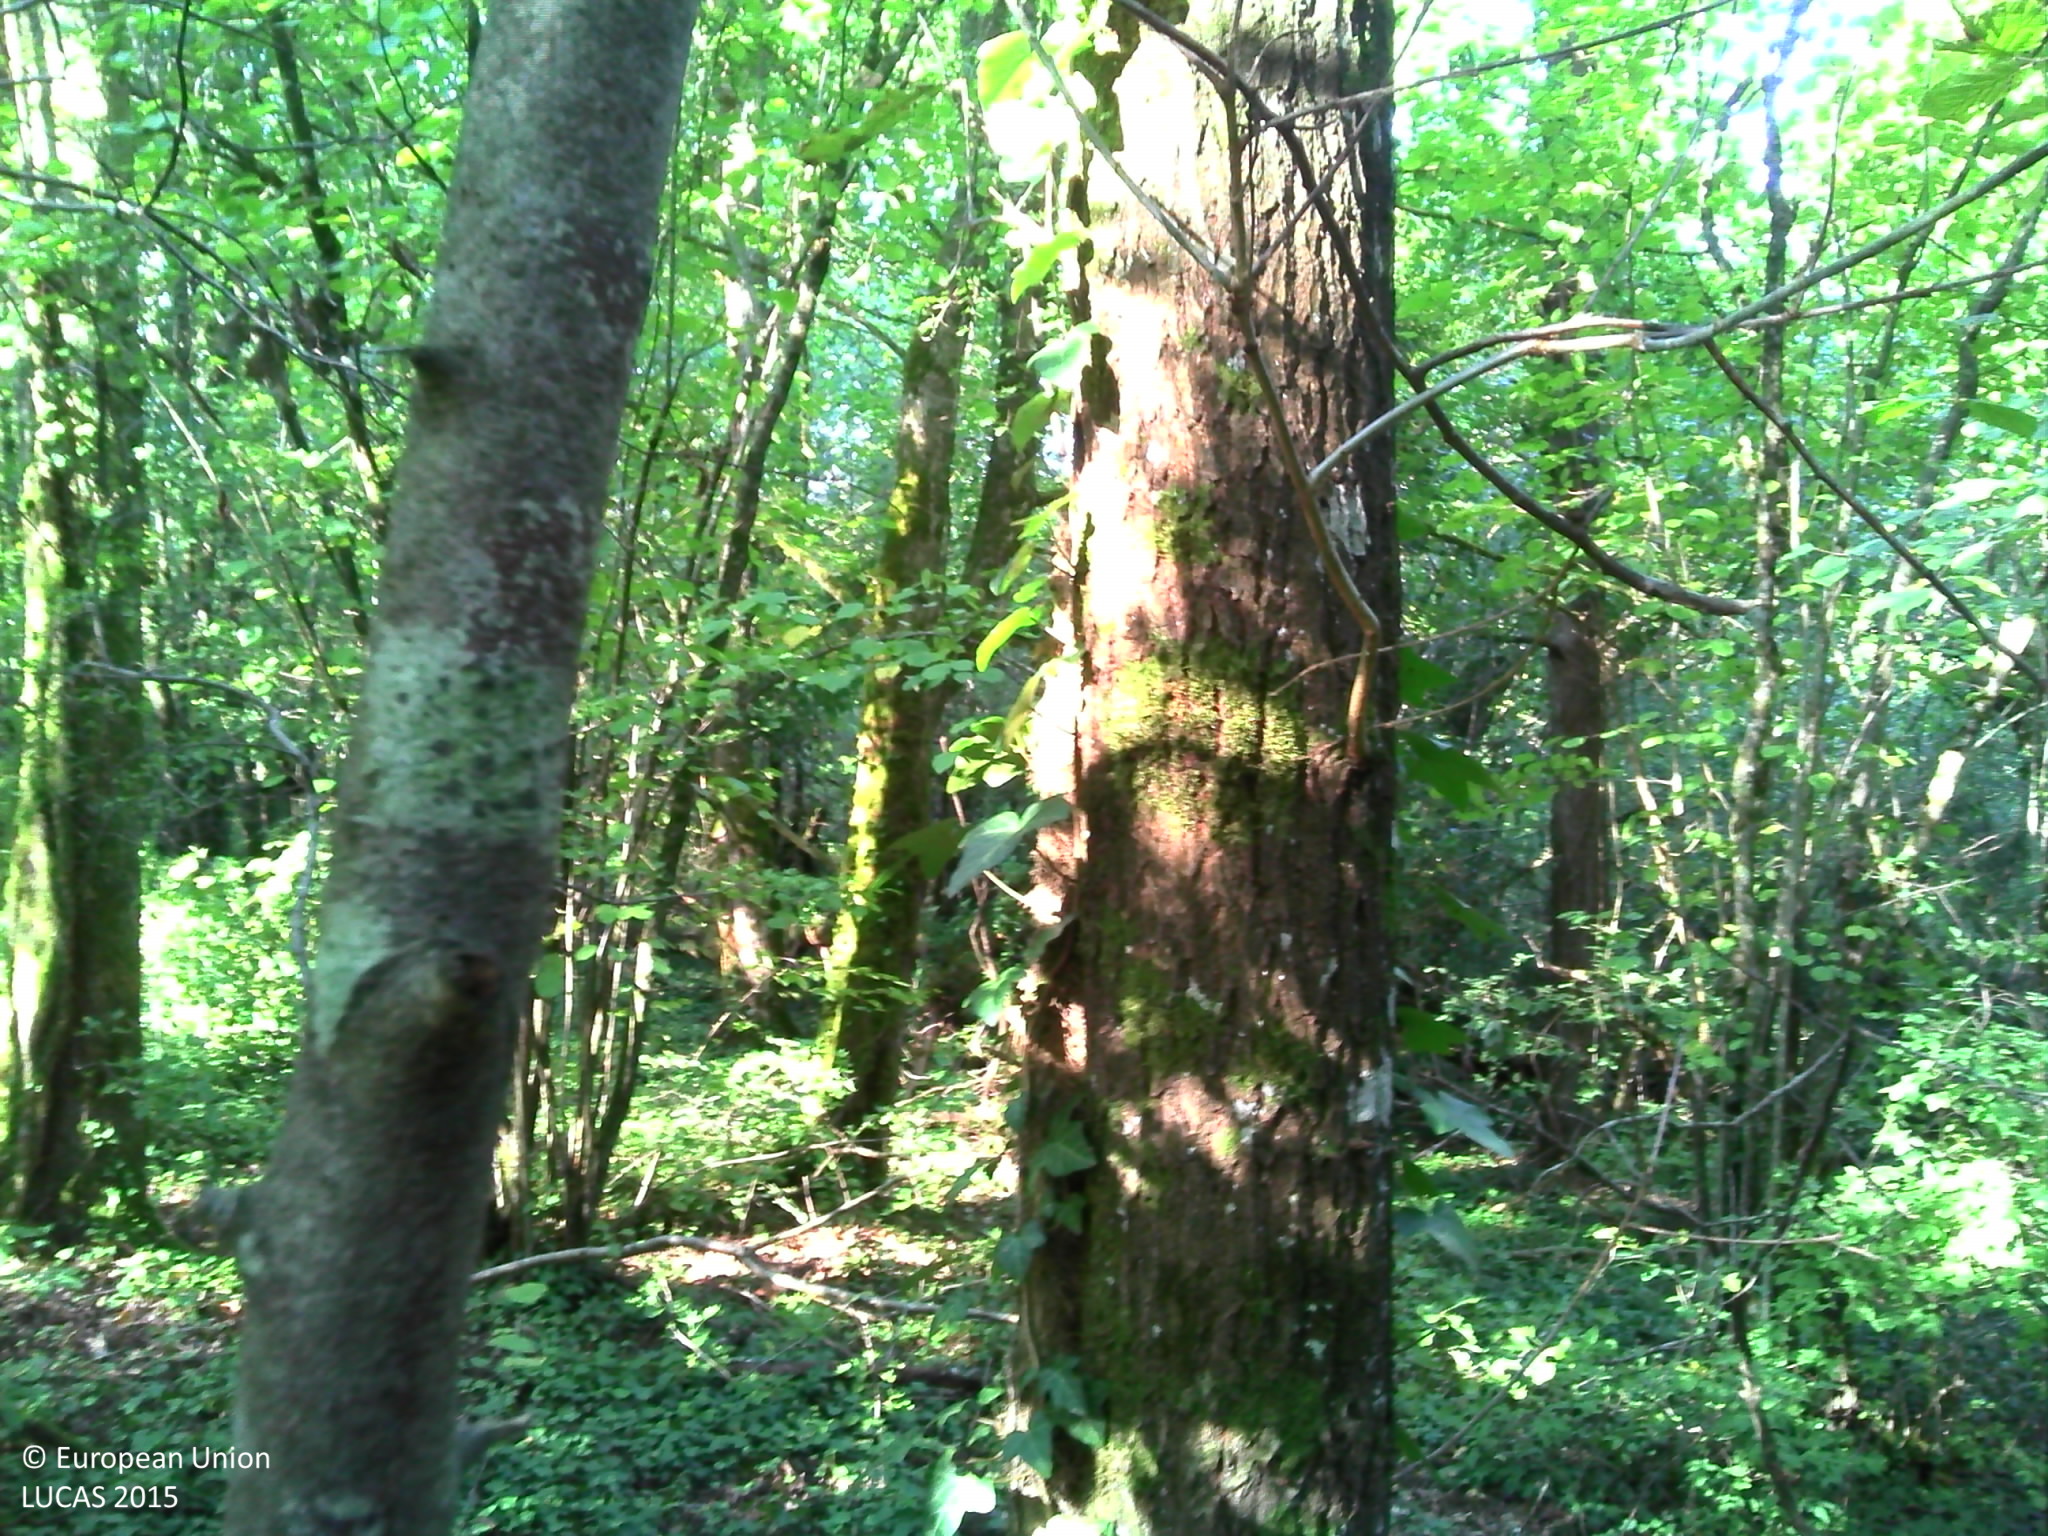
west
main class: Woodland
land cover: Broadleaved woodland
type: mesophytic deciduous forest
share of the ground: > 75 %
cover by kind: broadleaved forest trees 100 %
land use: Forestry
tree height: > 5 m
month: October
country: FR
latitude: 48.1337
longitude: 4.3673
